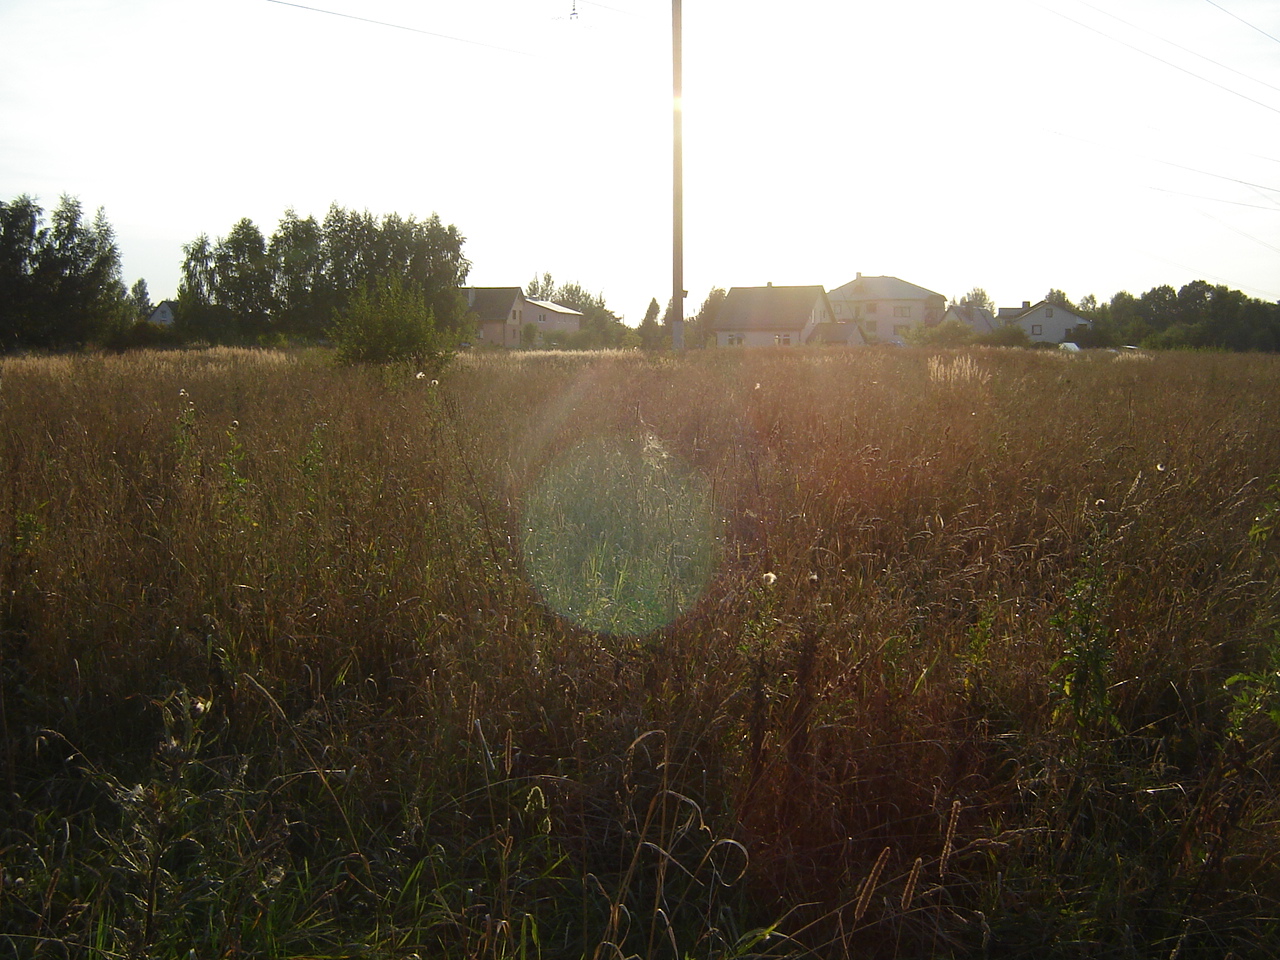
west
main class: Grassland
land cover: Grassland with sparse tree/shrub cover
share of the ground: > 75 %
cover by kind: herbaceous plants 95 %, broadleaved forest trees 5 %
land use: Fallow land
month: August
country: LT
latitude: 54.5812
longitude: 25.1732
